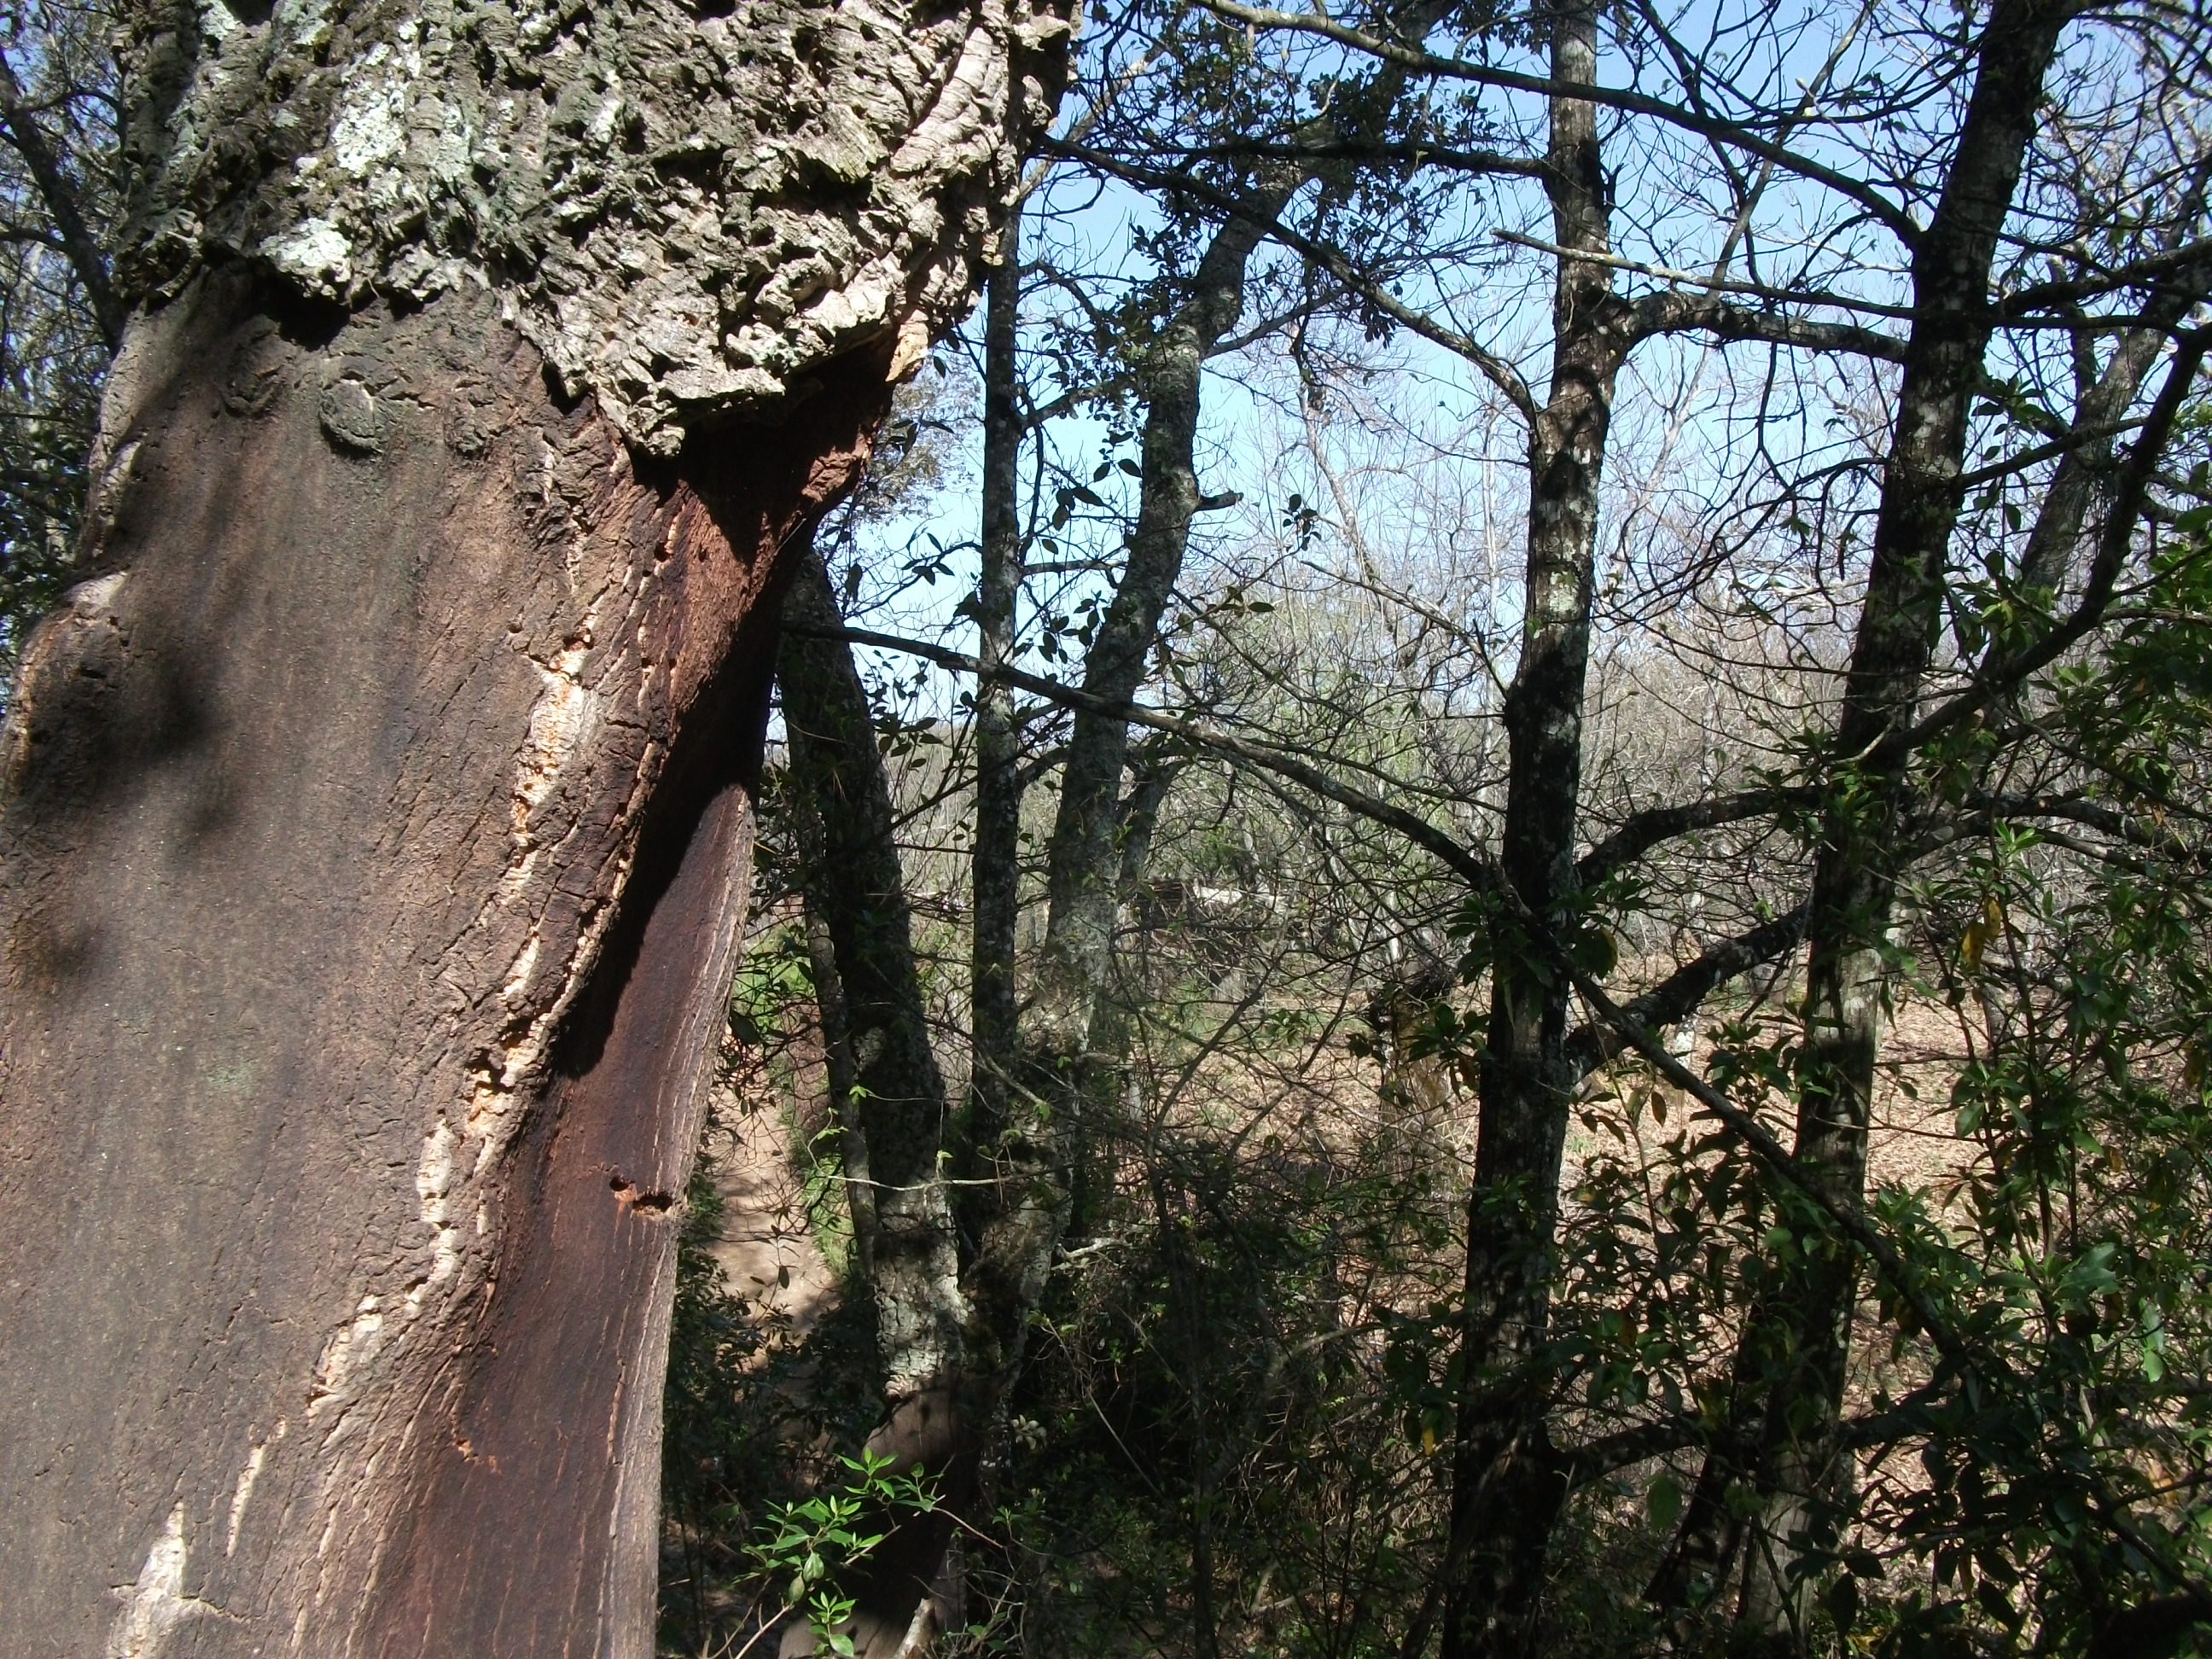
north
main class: Woodland
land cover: Broadleaved woodland
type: broadleaved evergreen forest
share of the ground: > 75 %
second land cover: Spontaneously vegetated surfaces
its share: < 10 %
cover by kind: broadleaved forest trees 95 %, herbaceous plants 5 %
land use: Forestry
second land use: Agriculture (excluding fallow land and kitchen gardens)
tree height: > 5 m
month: April
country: ES
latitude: 37.9149
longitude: -6.7339
